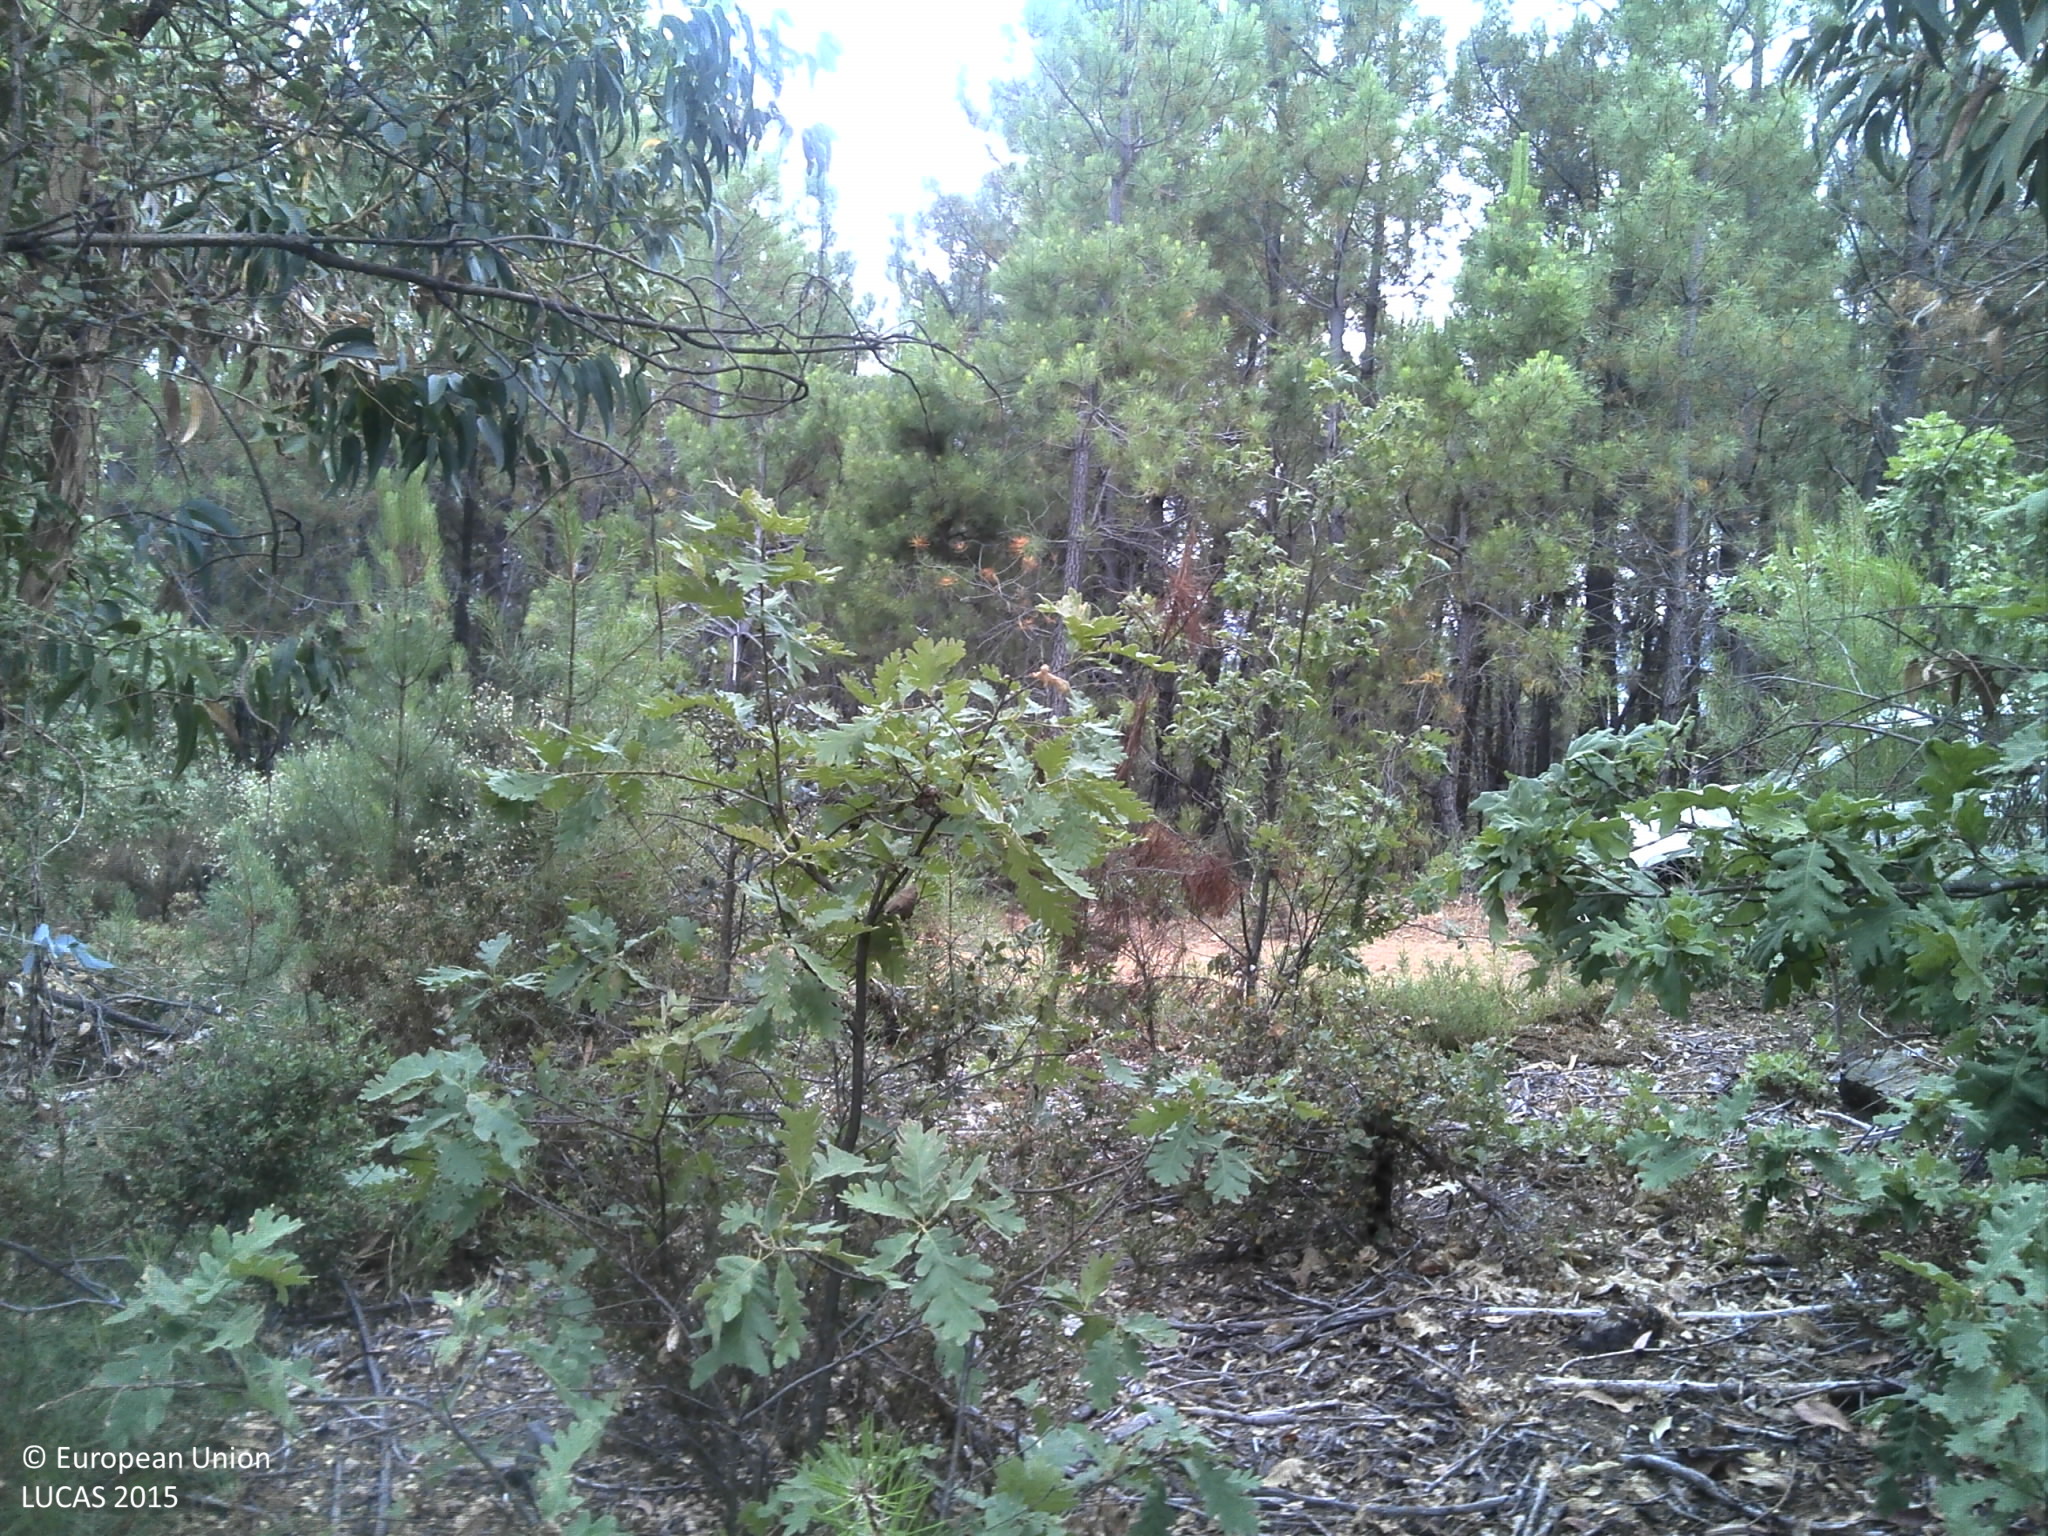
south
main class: Woodland
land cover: Pine dominated coniferous woodland
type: coniferous forest of the mediterranean region
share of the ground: 50 - 75 %
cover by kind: coniferous forest trees 55 %, shrubs 35 %, unconsolidated bare surface 10 %
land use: Forestry
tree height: > 5 m
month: June
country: PT
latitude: 40.2484
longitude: -7.3008
